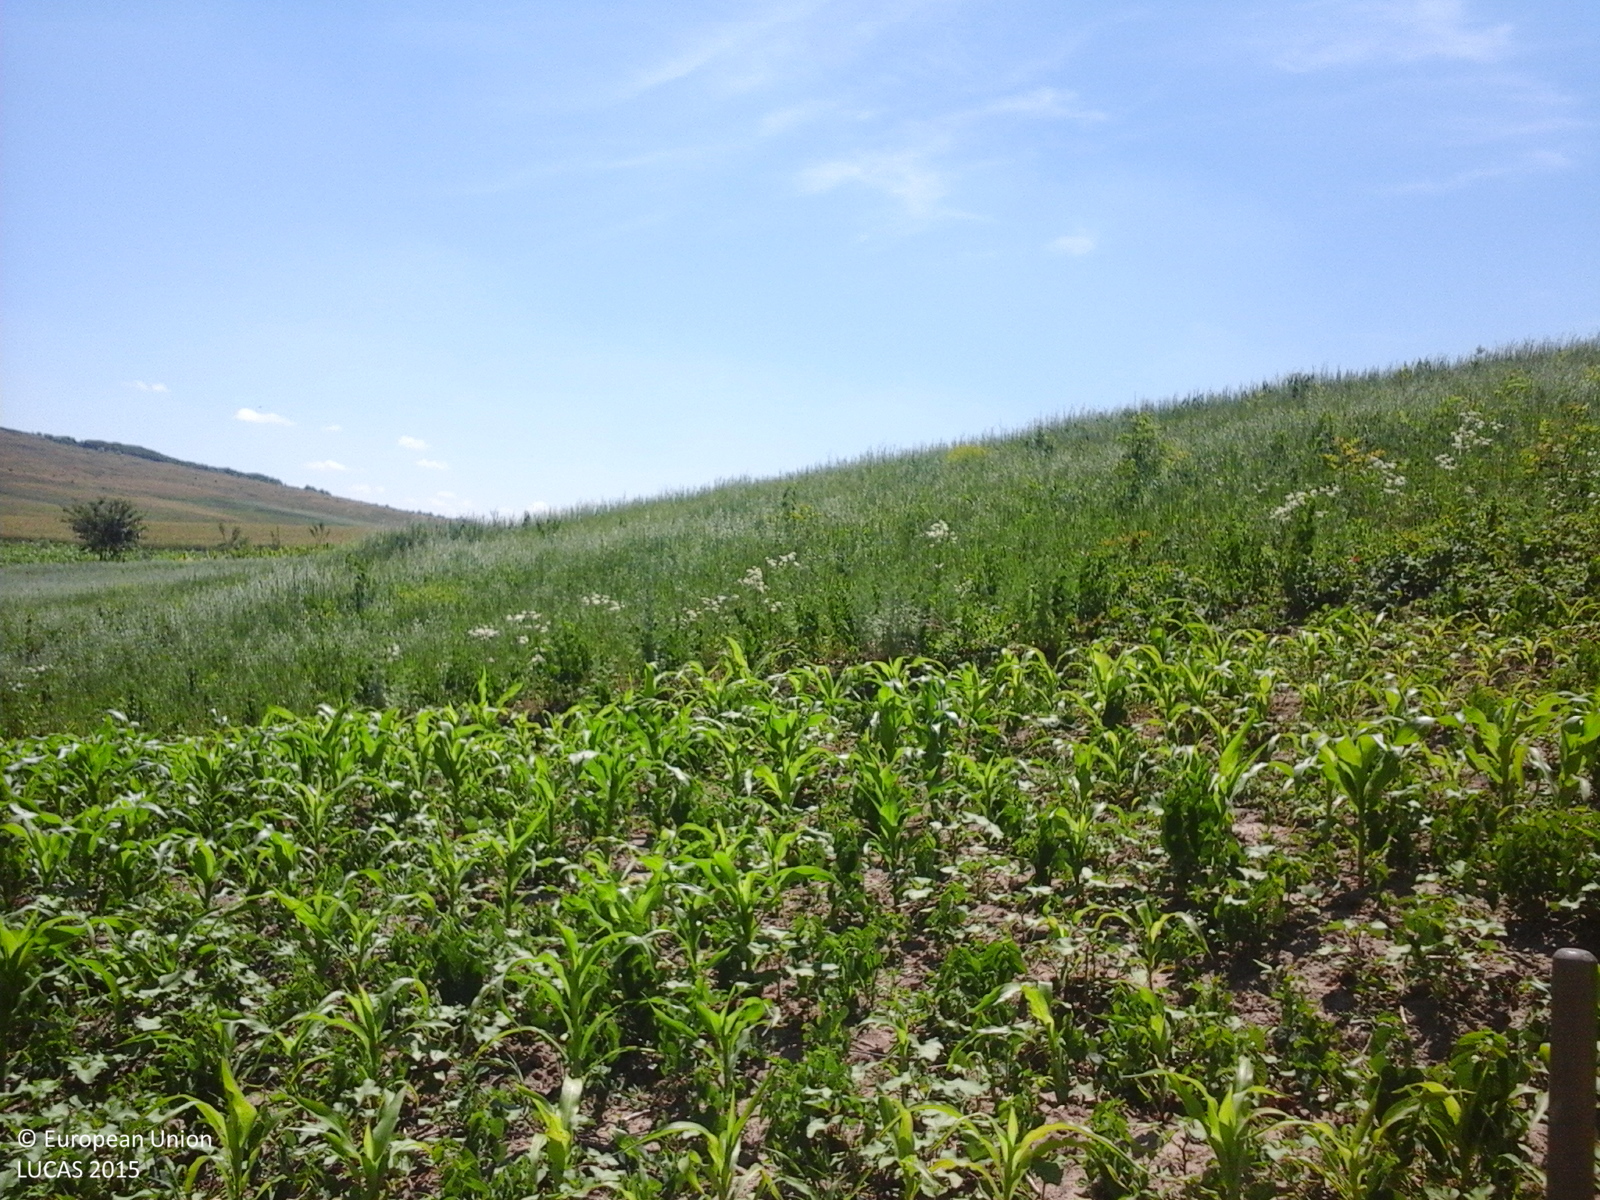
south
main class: Cropland
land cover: Maize
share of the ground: 25 - 50 %
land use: Agriculture (excluding fallow land and kitchen gardens)
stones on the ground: < 10 %
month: June
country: RO
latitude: 47.8653
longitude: 26.8788
